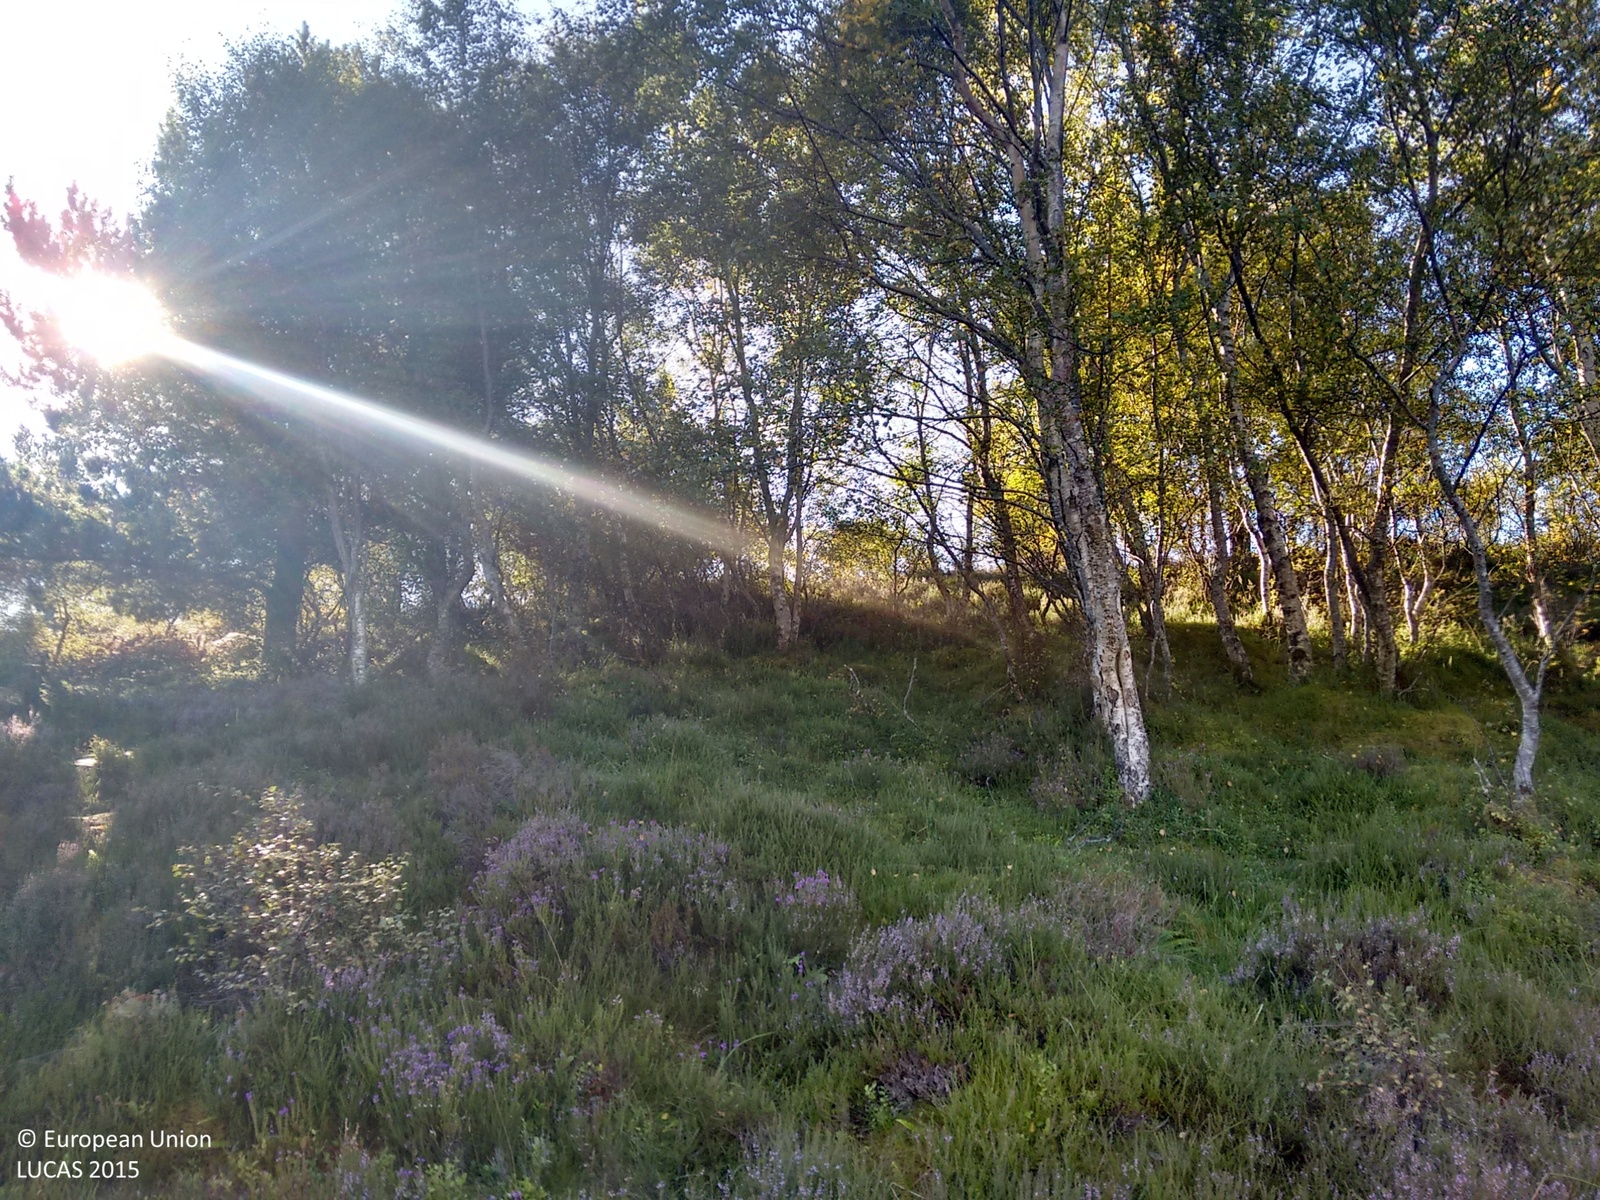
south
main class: Shrubland
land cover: Shrubland with sparse tree cover
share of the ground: > 75 %
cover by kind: shrubs 70 %, lichens and mosses 15 %, herbaceous plants 10 %, coniferous forest trees 5 %
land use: Forestry
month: September
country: GB
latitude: 57.7196
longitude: -4.3394
